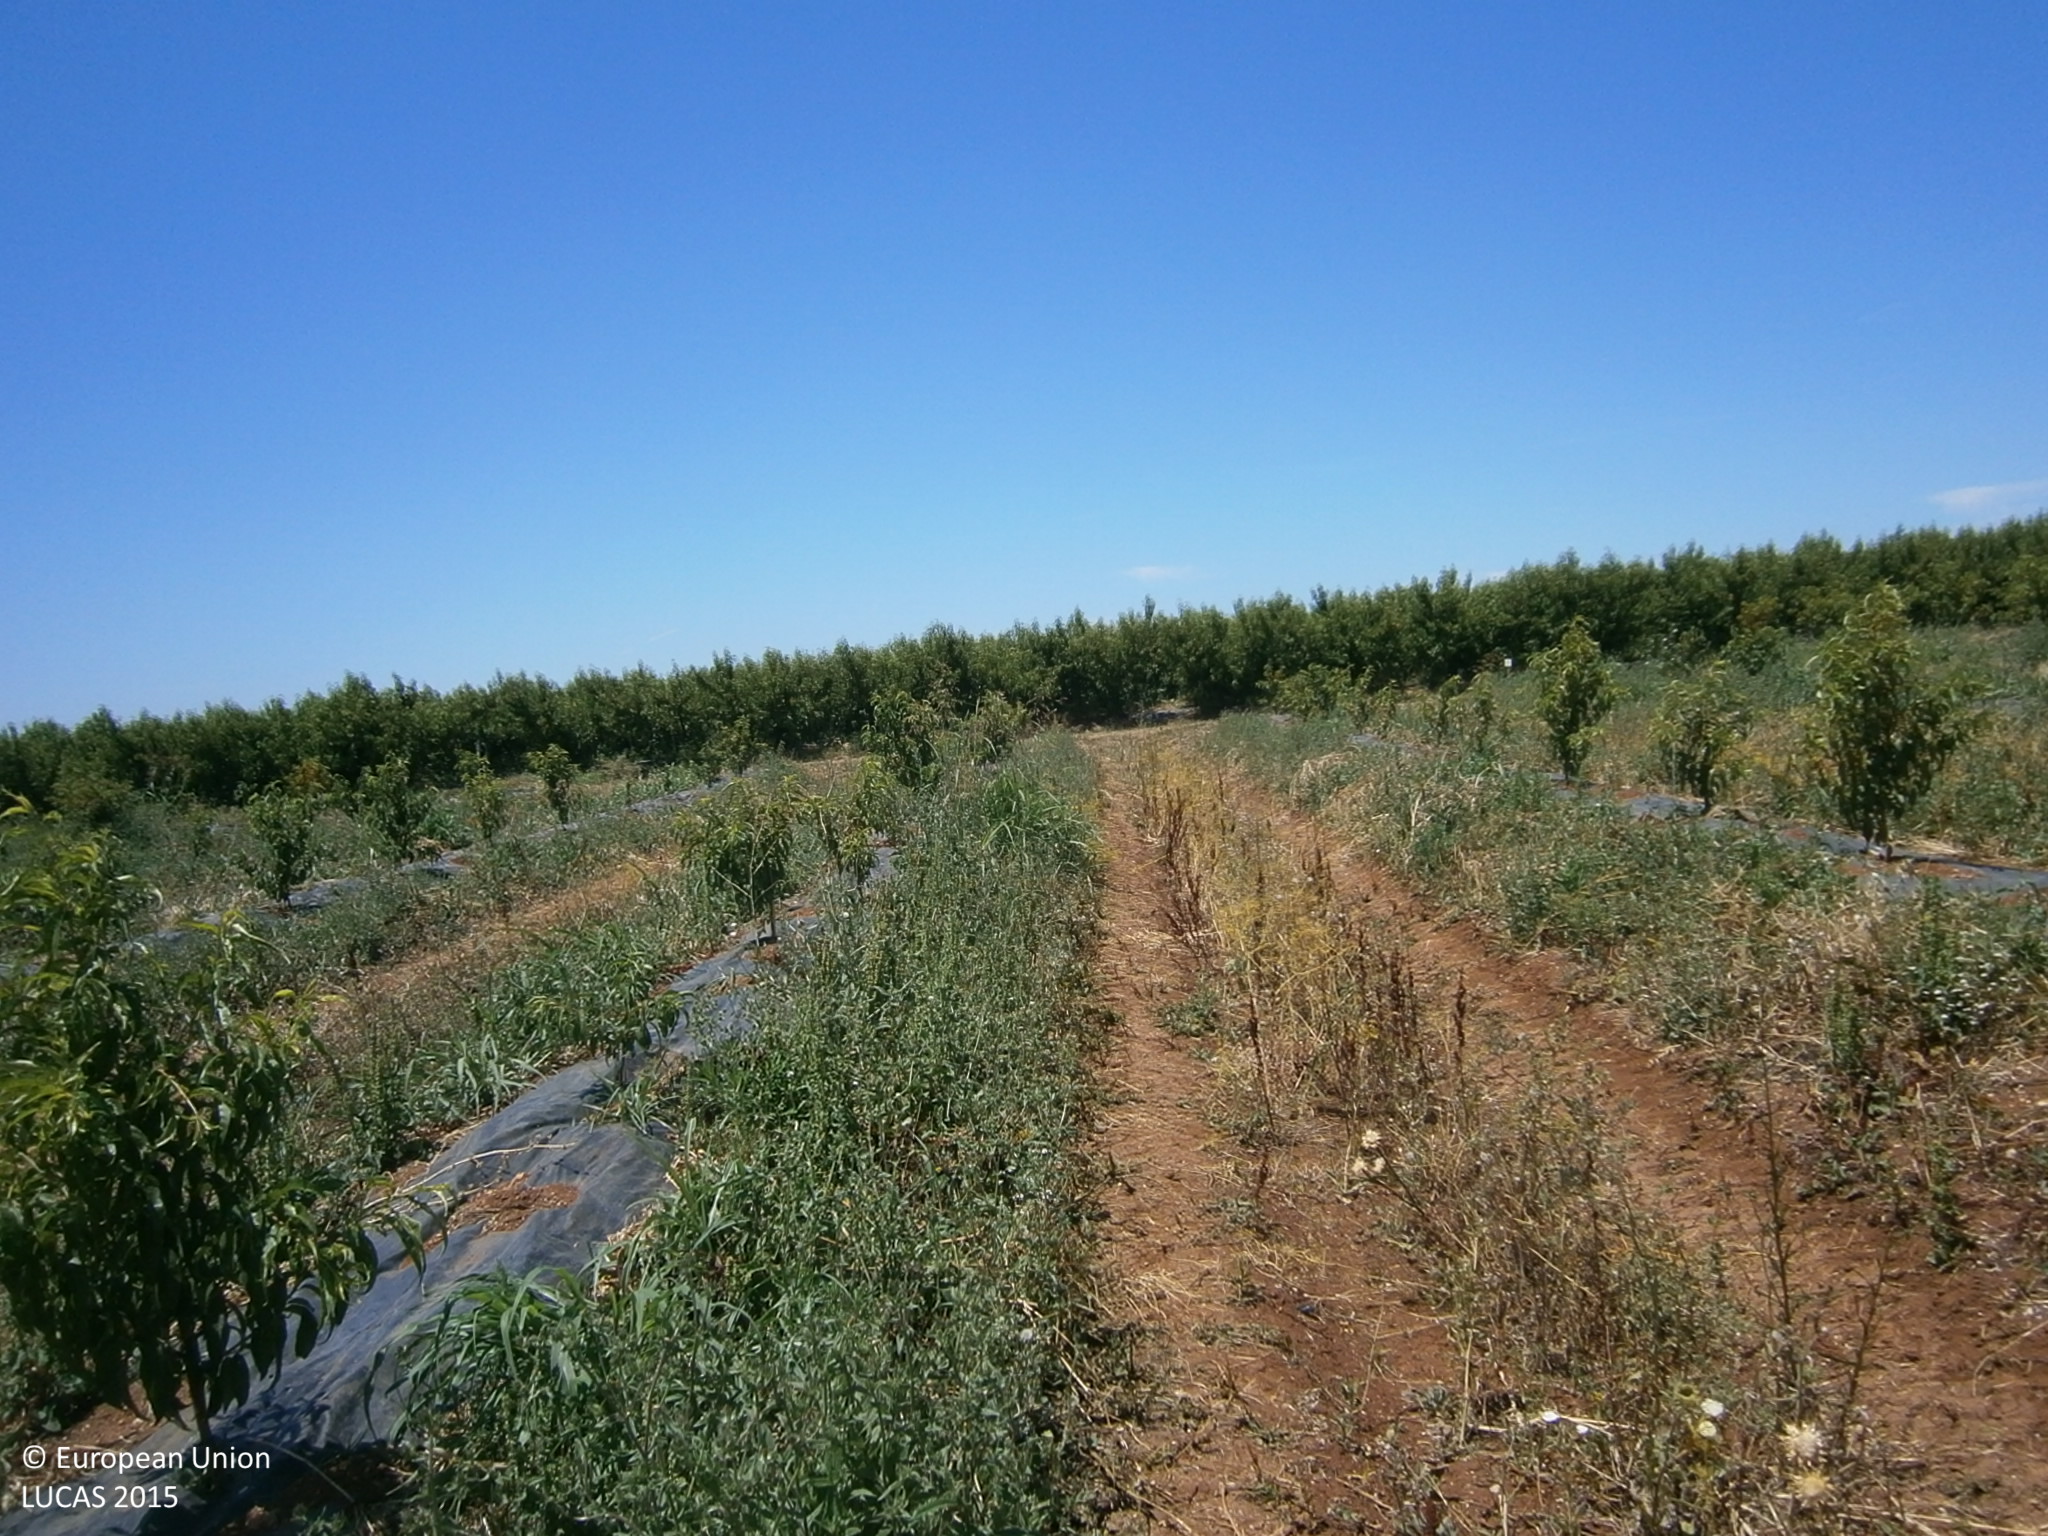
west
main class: Cropland
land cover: Other fruit trees and berries
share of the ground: 50 - 75 %
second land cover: Spontaneously vegetated surfaces
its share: 10 - 25 %
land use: Agriculture (excluding fallow land and kitchen gardens)
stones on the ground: < 10 %
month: June
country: ES
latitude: 38.9370
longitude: -6.6890
